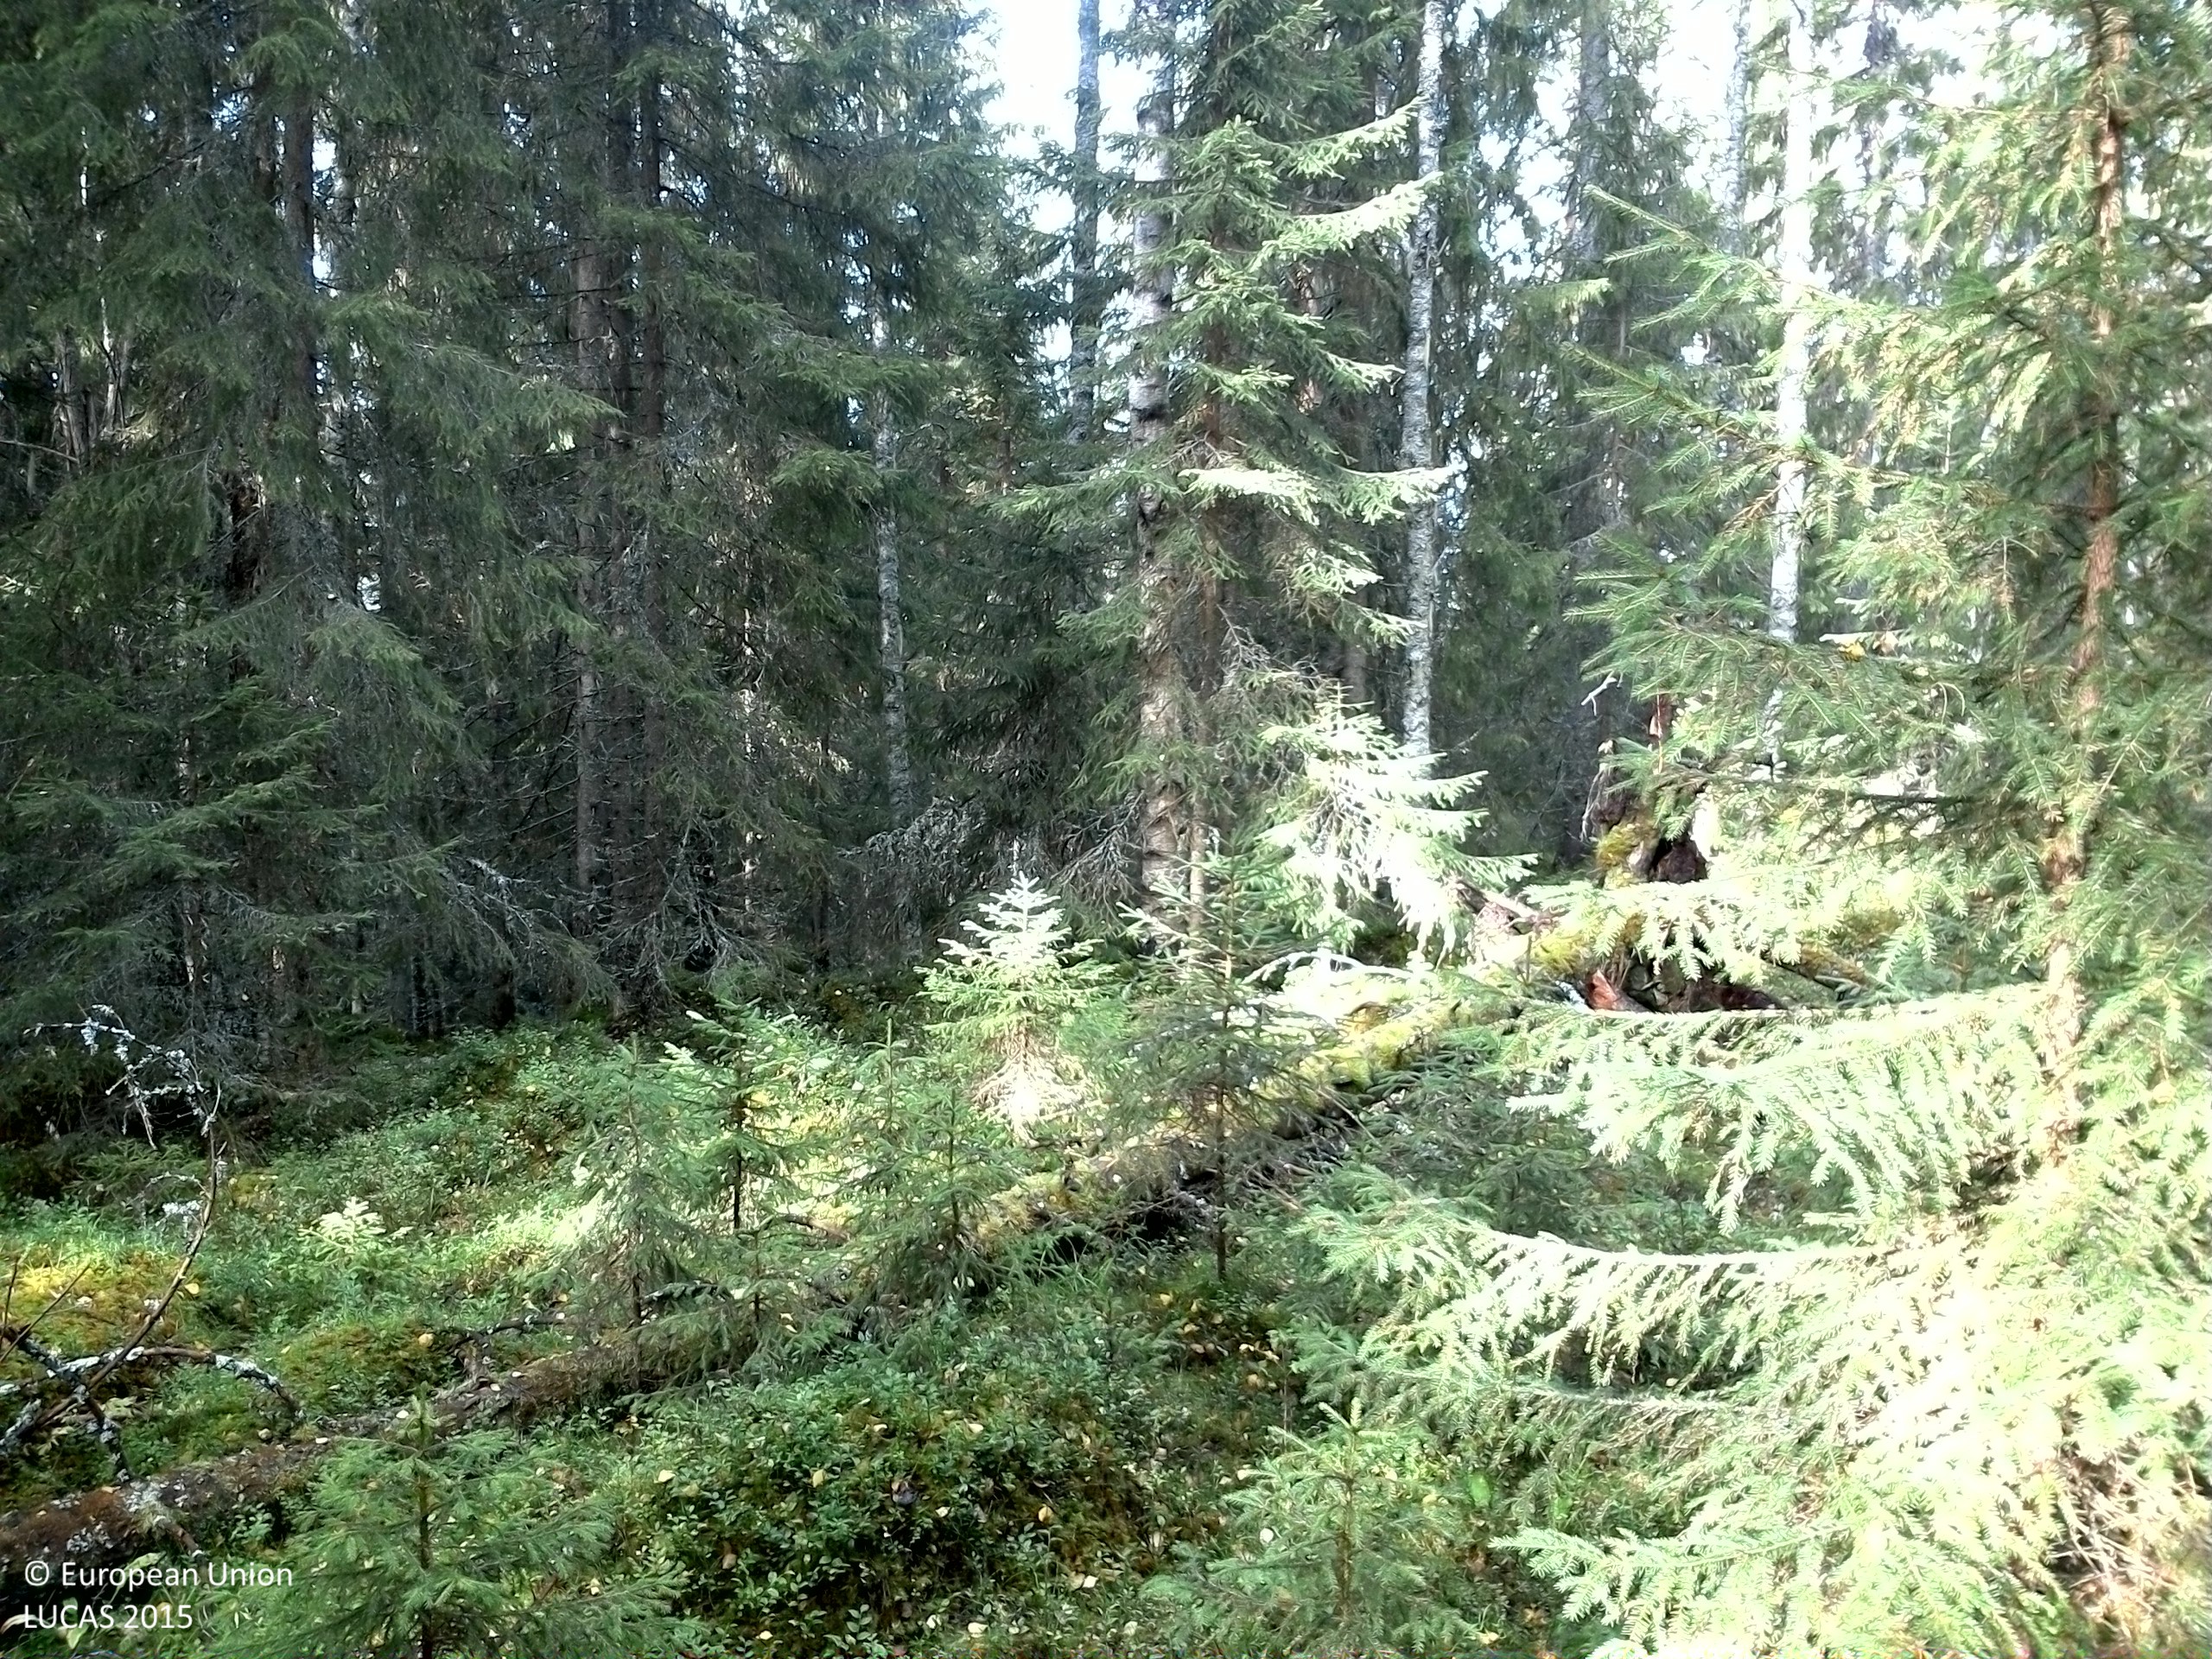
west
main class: Woodland
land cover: Spruce dominated mixed woodland
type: boreal forest
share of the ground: 50 - 75 %
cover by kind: coniferous forest trees 45 %, shrubs 25 %, broadleaved forest trees 15 %, lichens and mosses 15 %
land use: Forestry
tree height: > 5 m
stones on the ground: 10 - 25 %
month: September
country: SE
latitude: 61.3443
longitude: 15.3123
